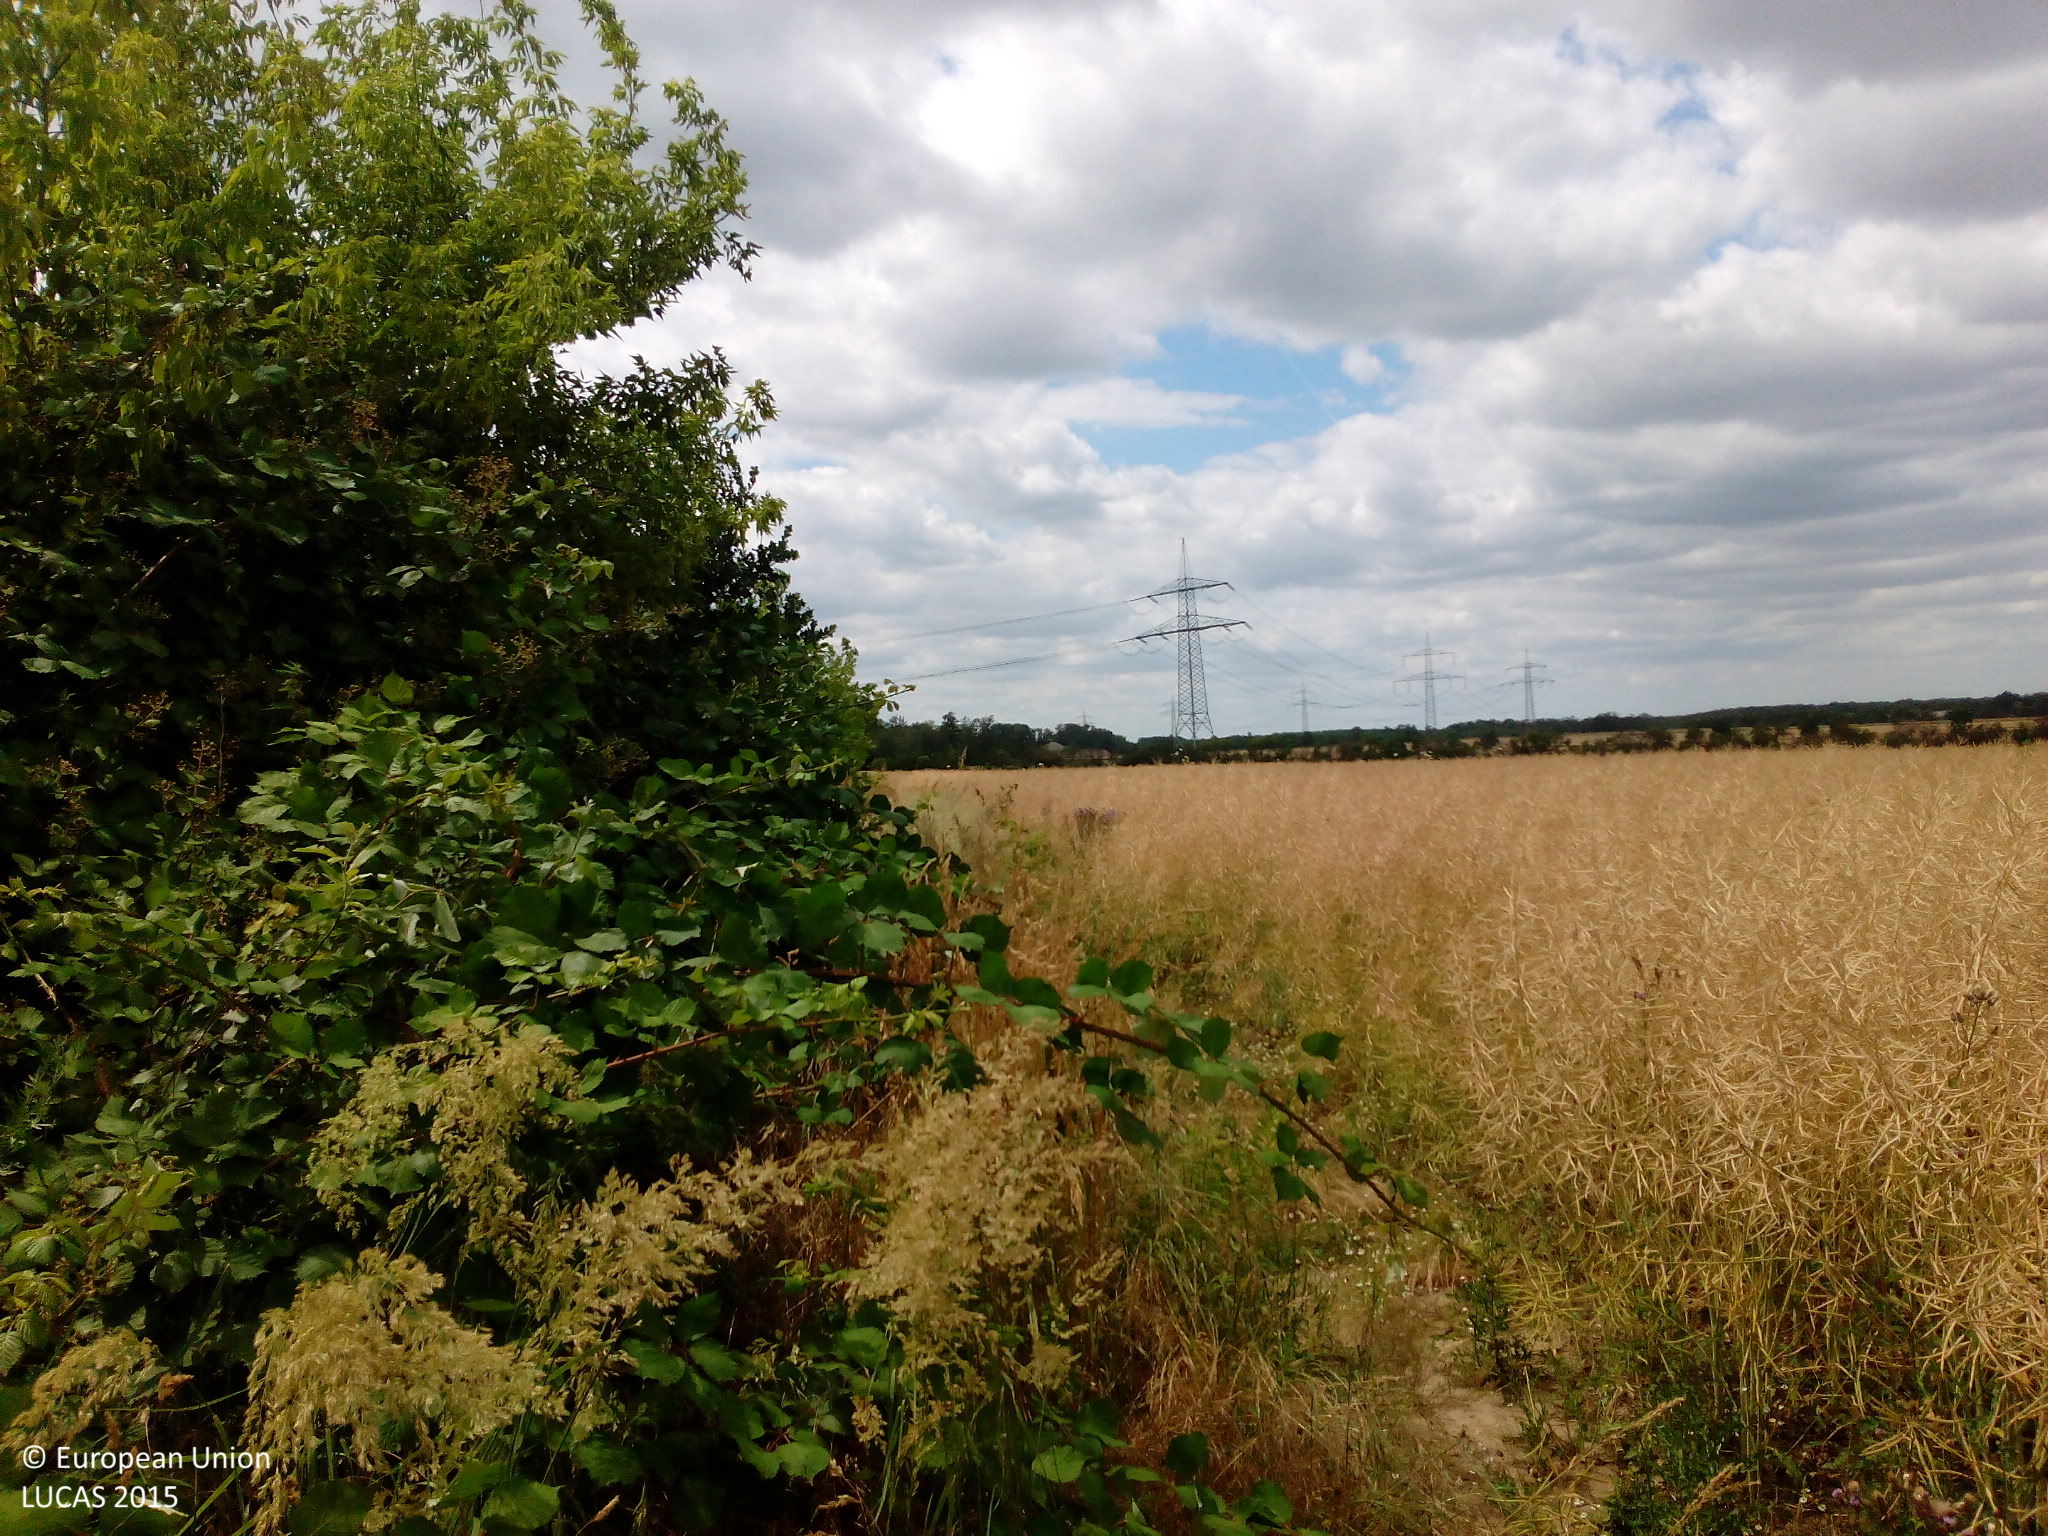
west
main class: Cropland
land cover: Rape and turnip rape
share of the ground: > 75 %
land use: Agriculture (excluding fallow land and kitchen gardens)
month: July
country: DE
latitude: 51.2007
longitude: 12.4757
